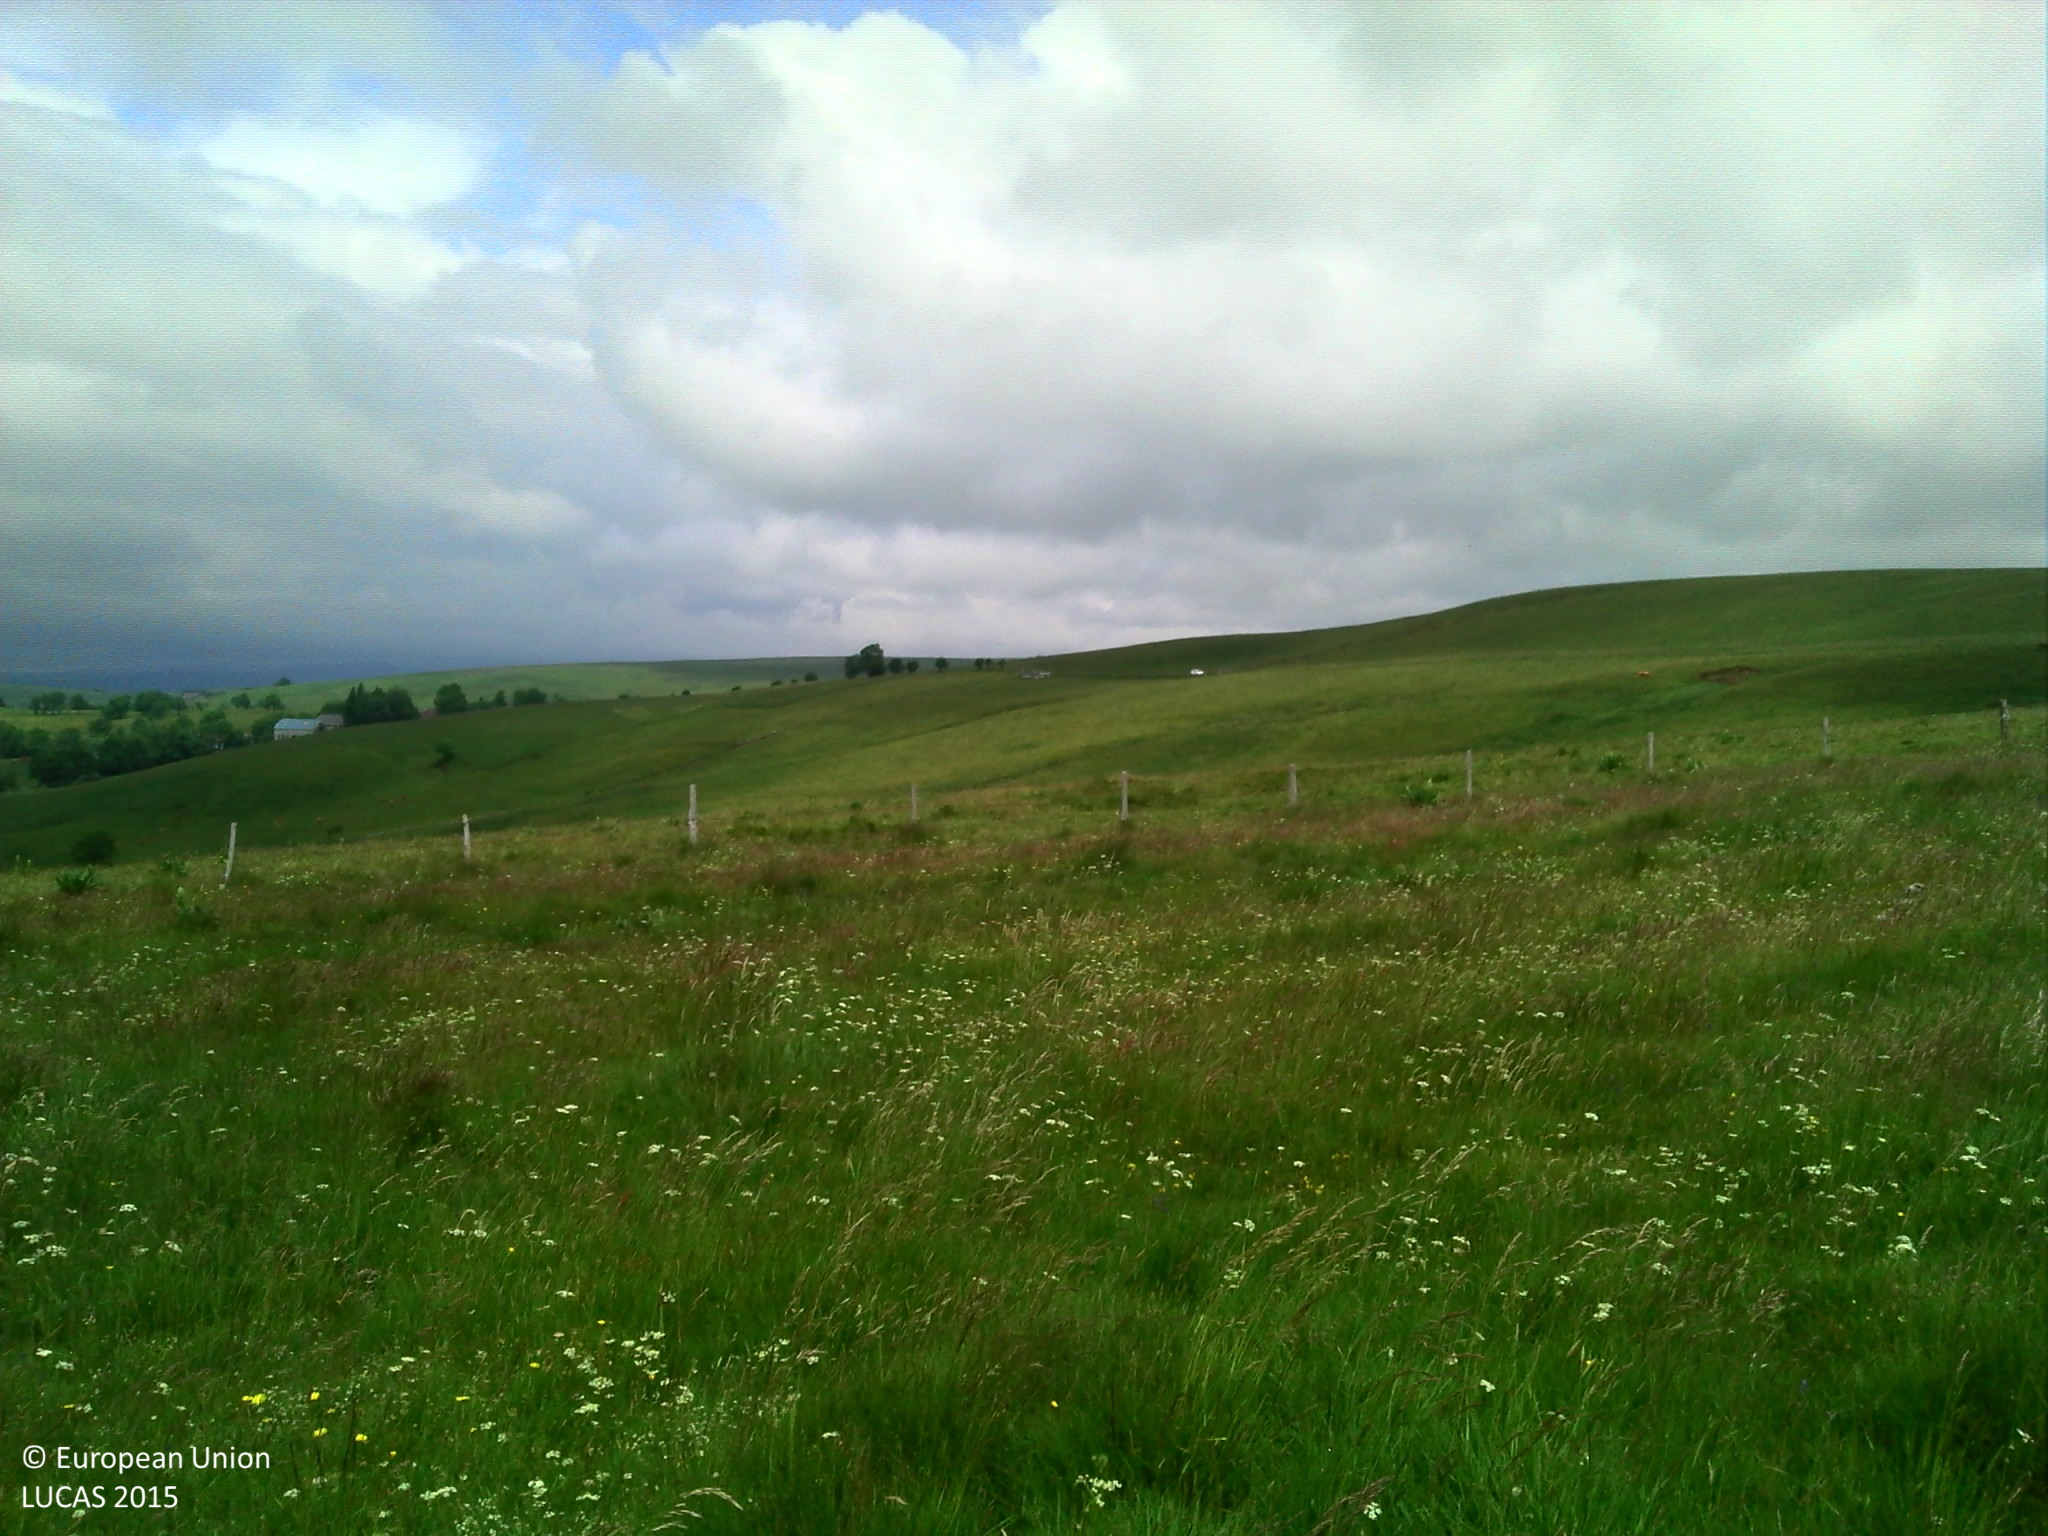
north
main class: Grassland
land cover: Grassland without tree/shrub cover
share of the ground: > 75 %
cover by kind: herbaceous plants 100 %
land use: Agriculture (excluding fallow land and kitchen gardens)
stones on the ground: < 10 %
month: June
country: FR
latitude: 45.3371
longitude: 2.8927
